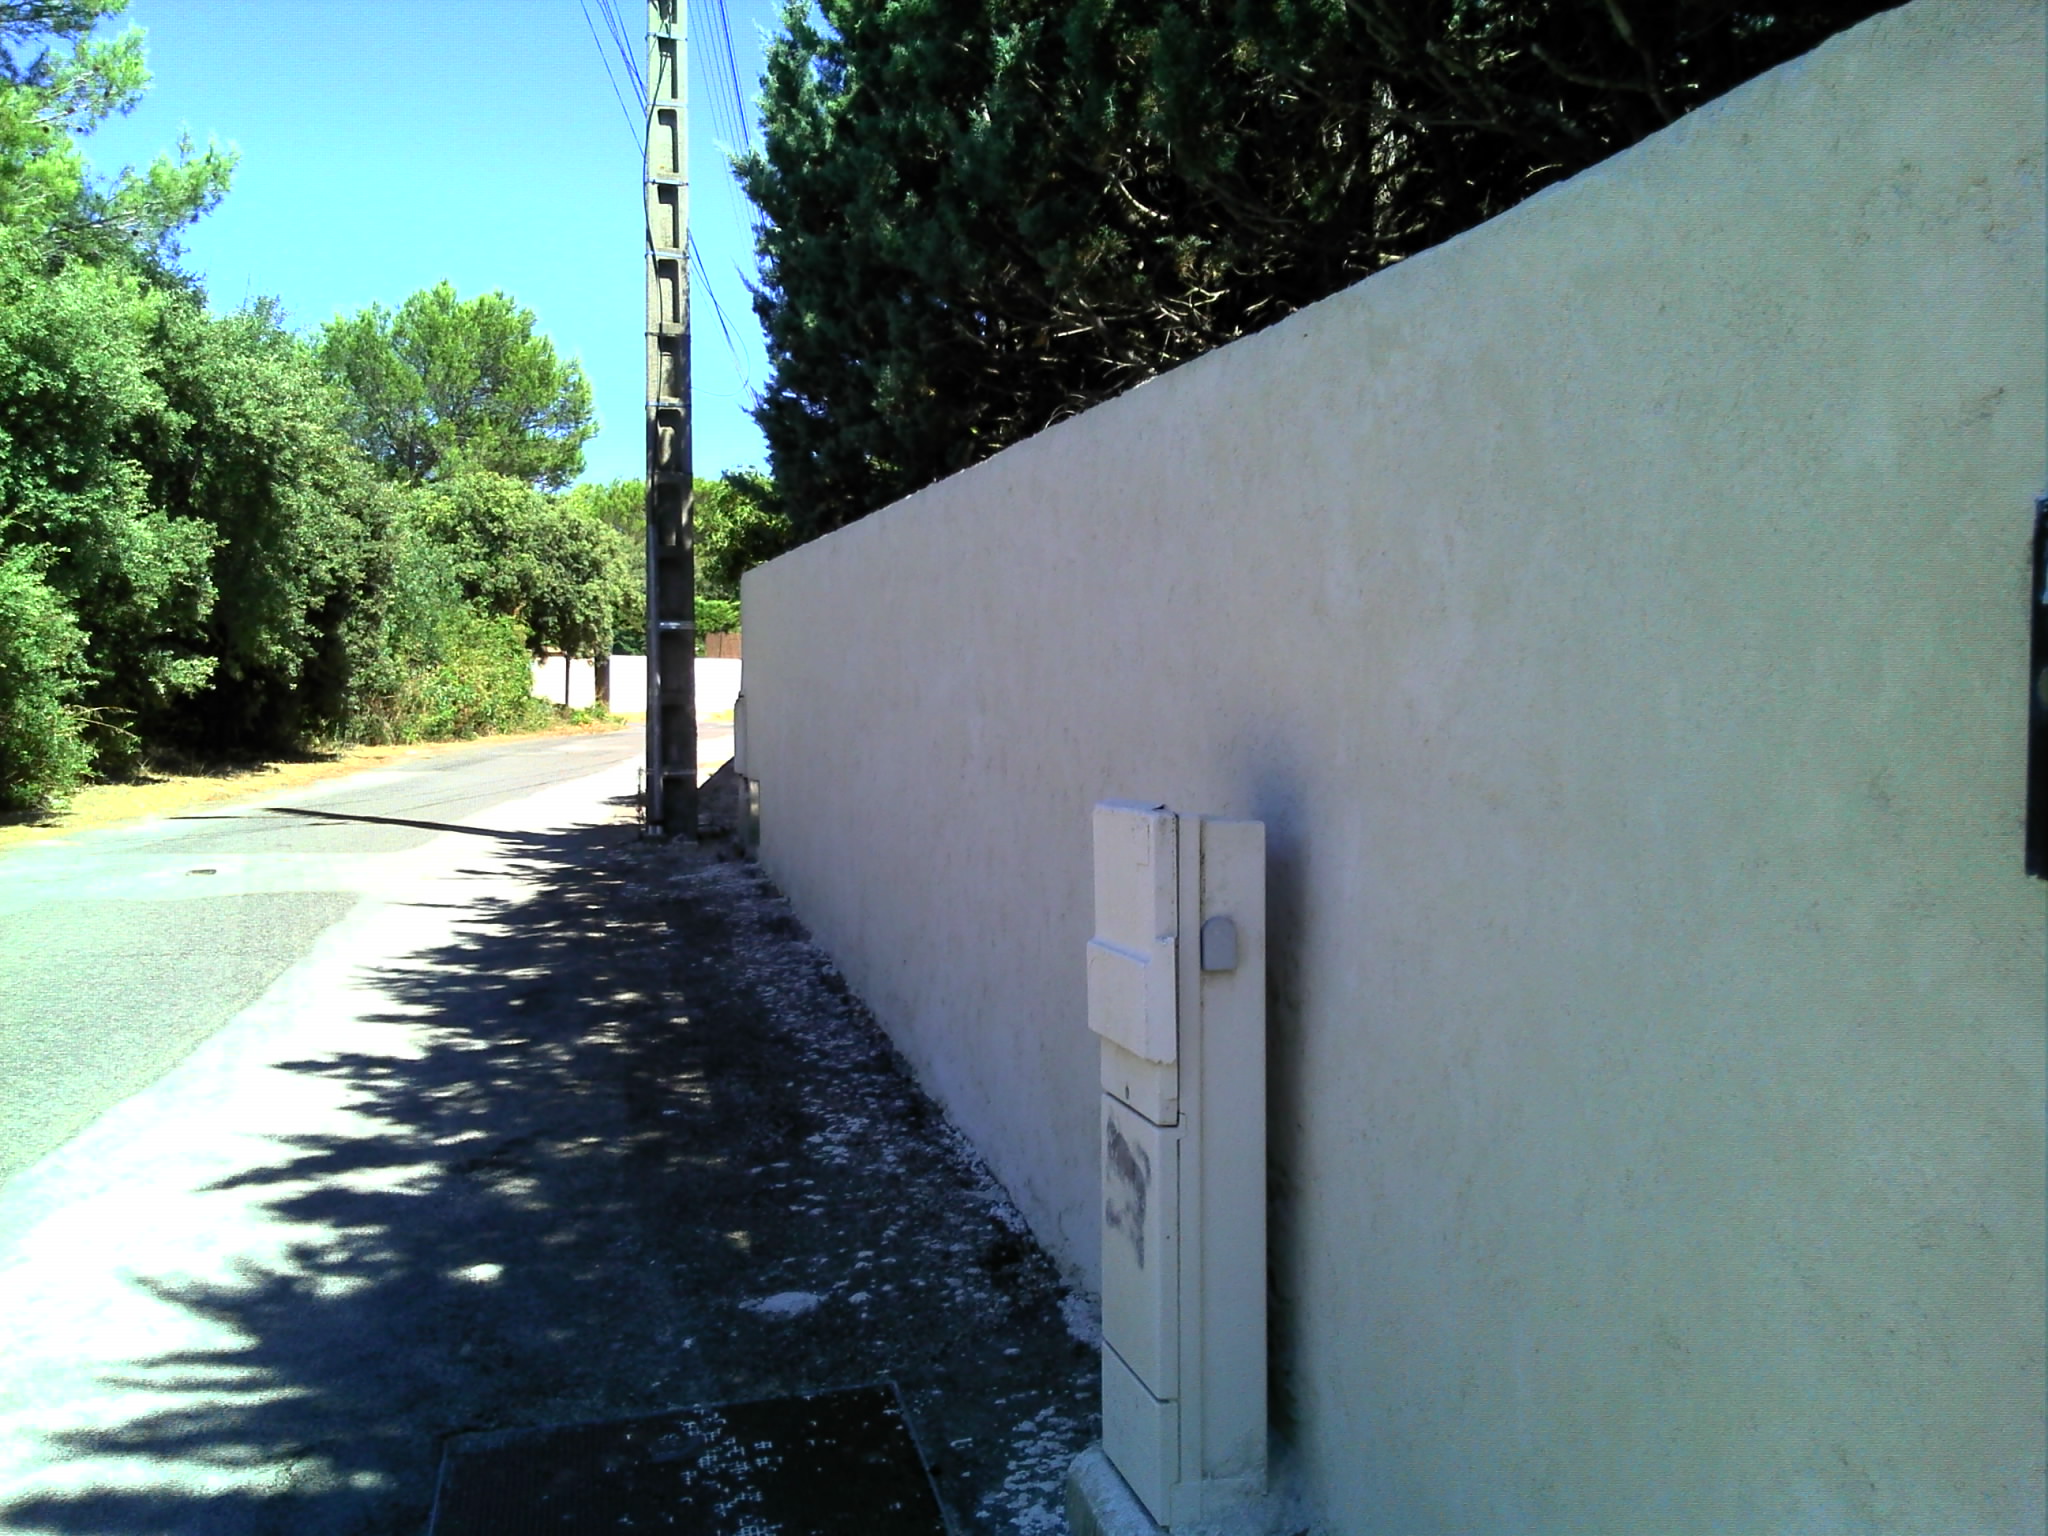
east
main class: Grassland
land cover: Grassland with sparse tree/shrub cover
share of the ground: > 75 %
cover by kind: herbaceous plants 95 %, broadleaved forest trees 5 %
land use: Residential
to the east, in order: Grassland with sparse tree/shrub cover; Artificial constructions in urban areas
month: July
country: FR
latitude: 43.8517
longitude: 4.3236
